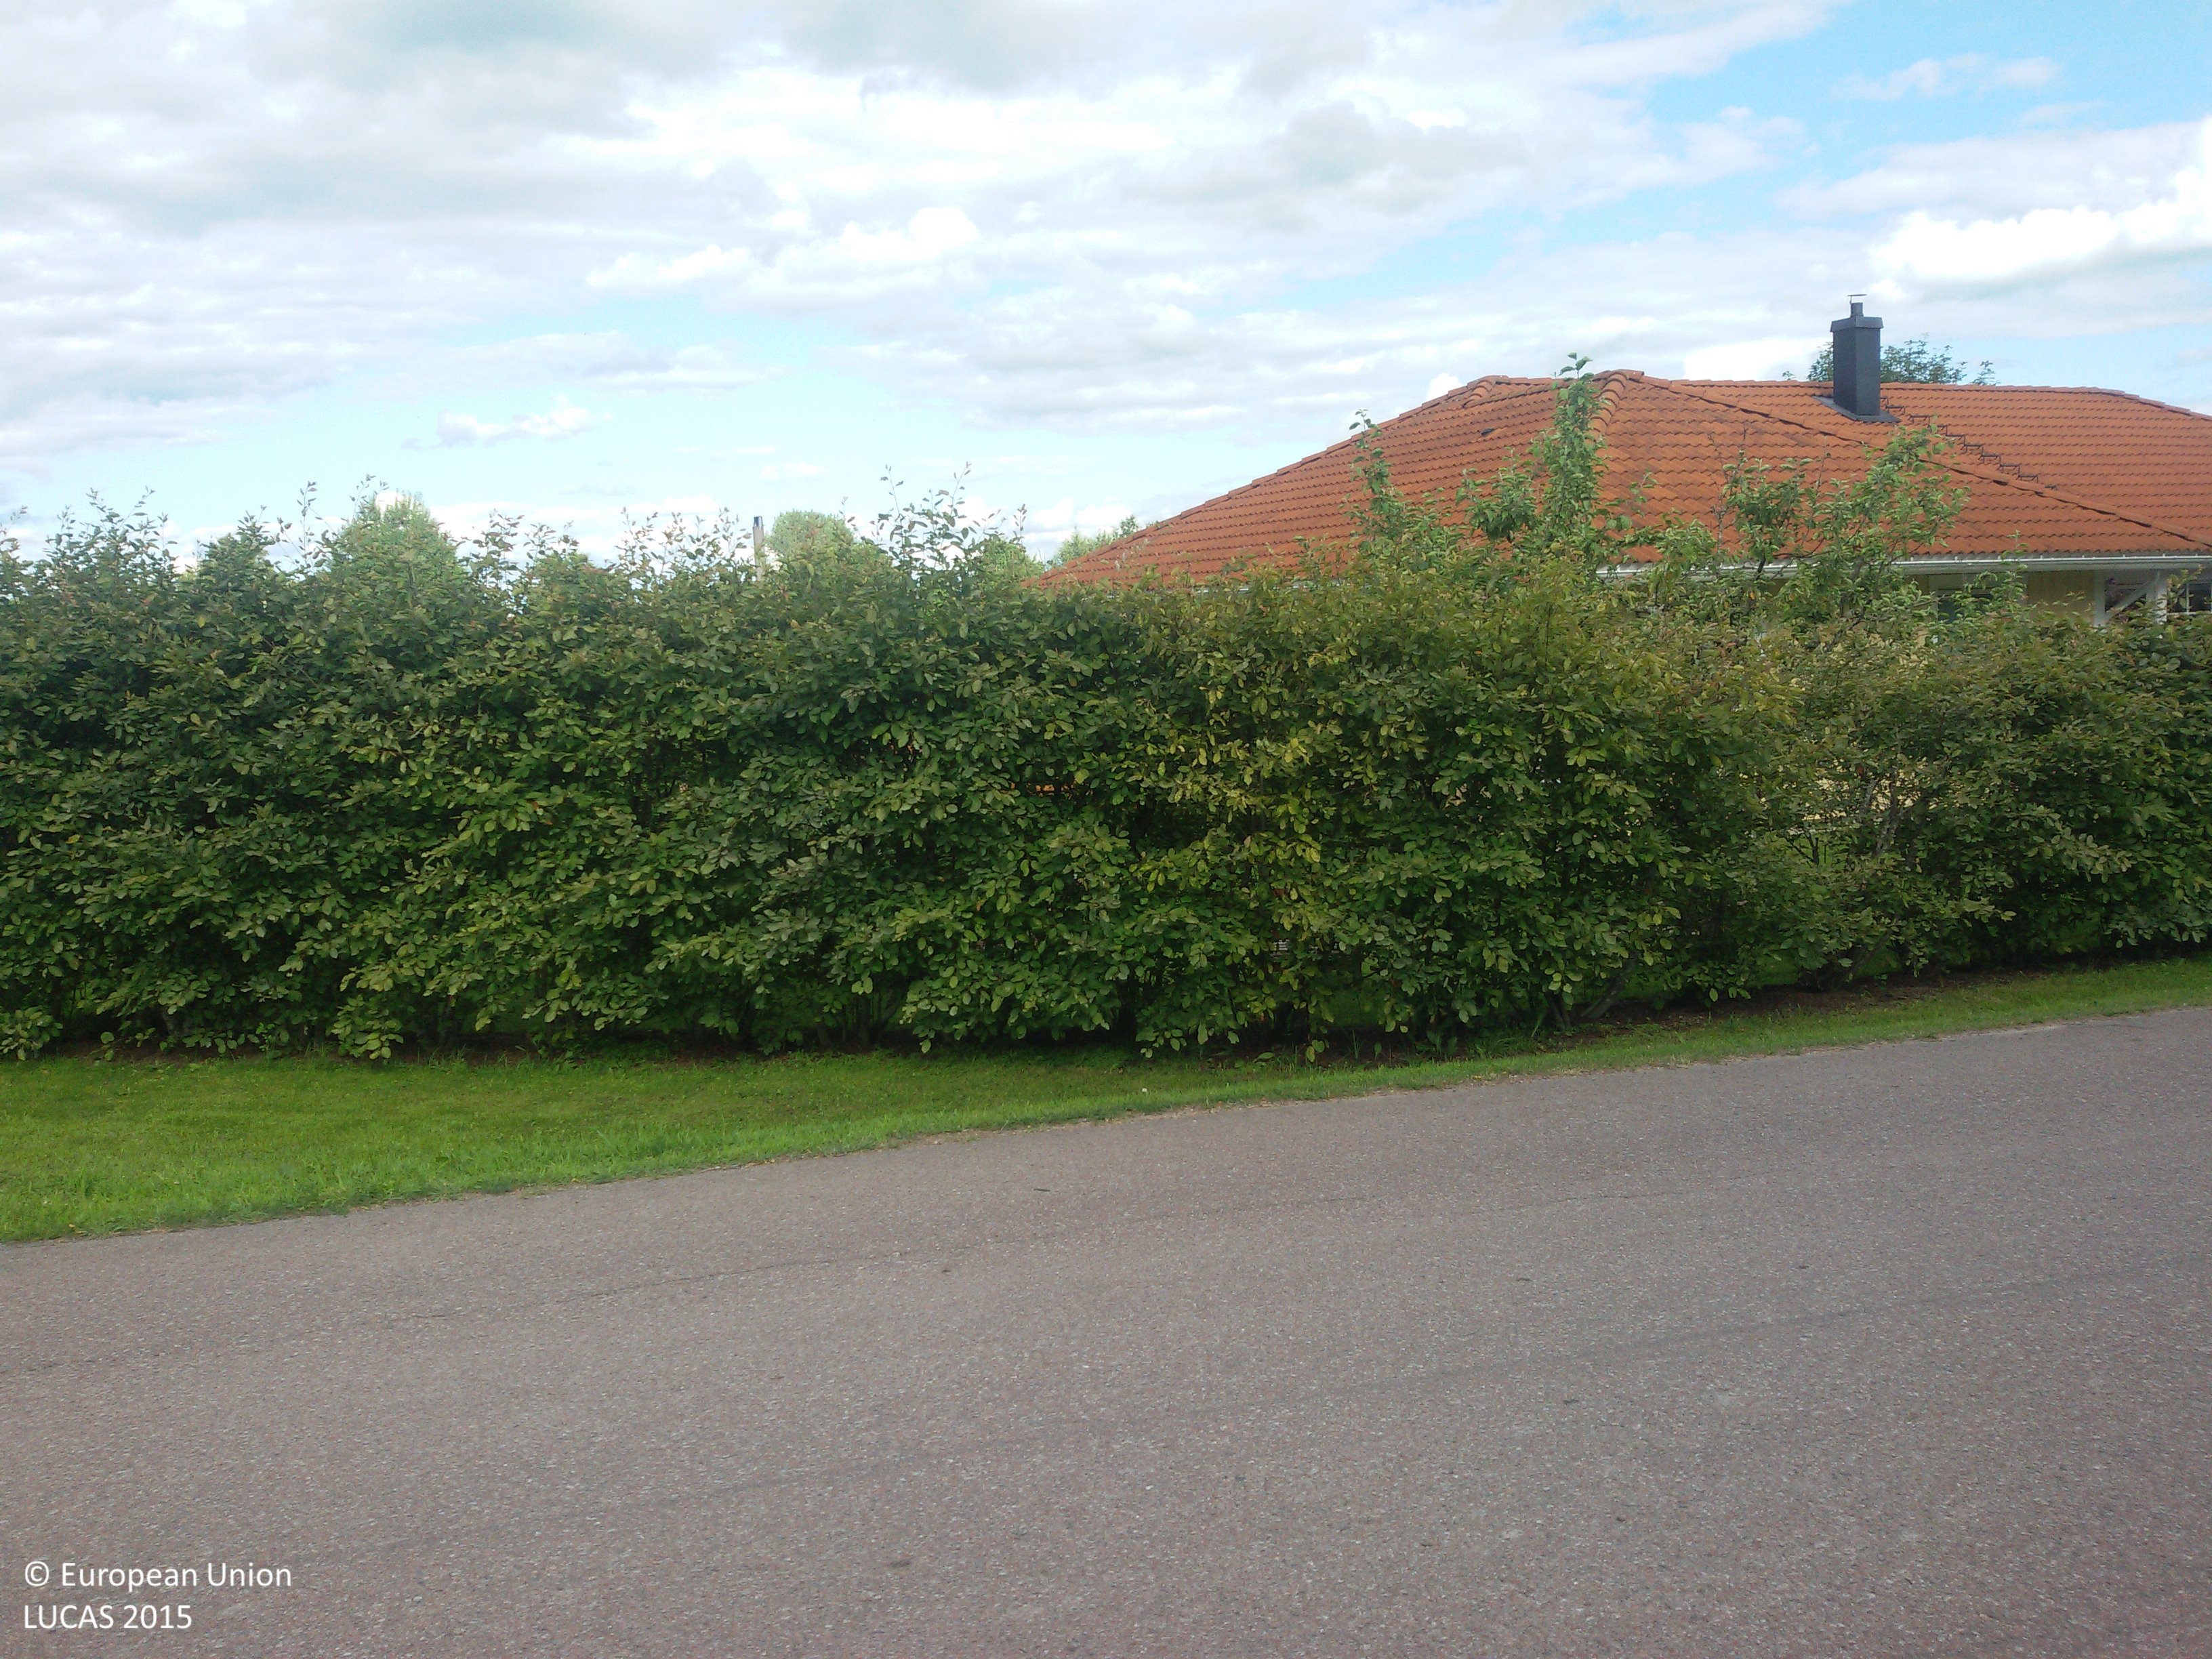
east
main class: Grassland
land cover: Grassland without tree/shrub cover
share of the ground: > 75 %
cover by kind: herbaceous plants 100 %
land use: Road transport
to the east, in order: Grassland without tree/shrub cover; Paved roads, cycling and walking lanes; Grass margins; Managed hedges; Artificial constructions in urban areas; Grassland without tree/shrub cover; Artificial constructions in urban areas
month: July
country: SE
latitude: 60.4748
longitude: 15.3906
